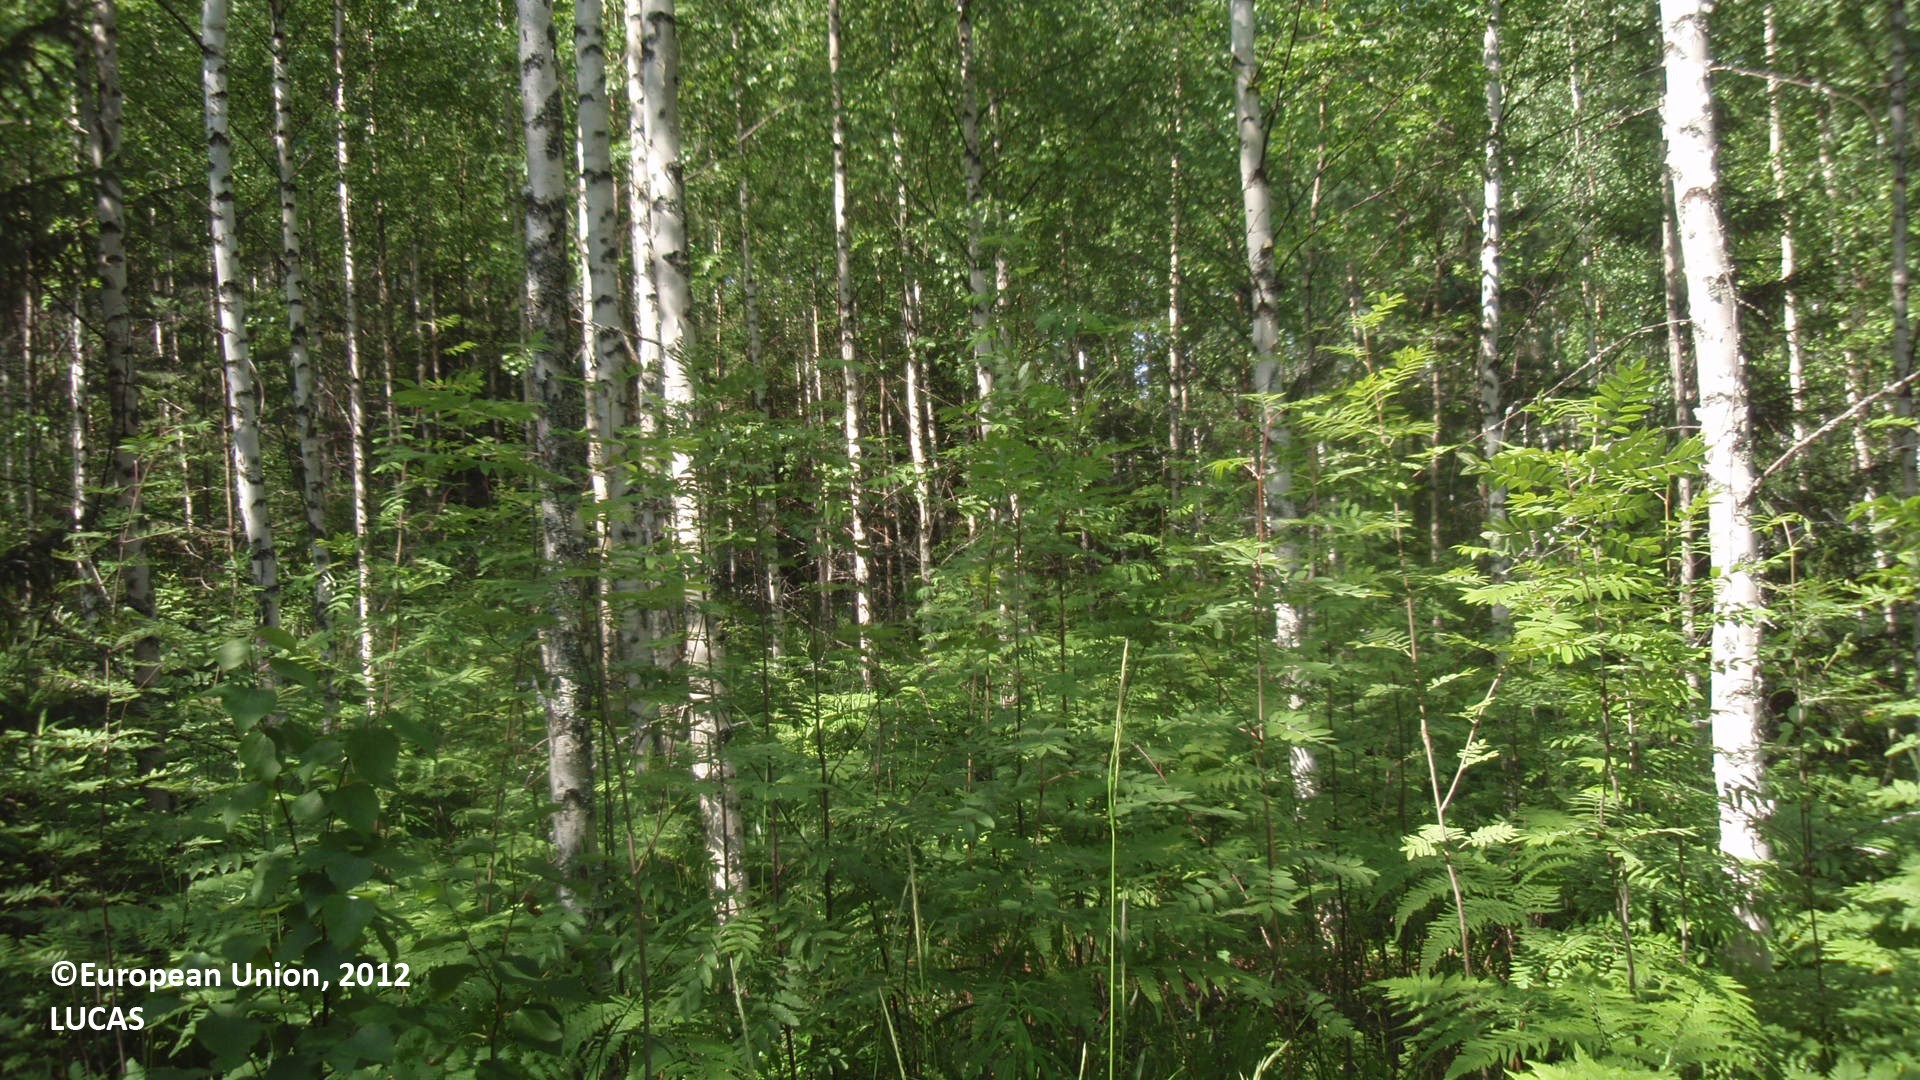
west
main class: Woodland
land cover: Broadleaved woodland
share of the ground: 50 - 75 %
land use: Forestry
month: July
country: FI
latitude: 61.5845
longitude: 29.1684
